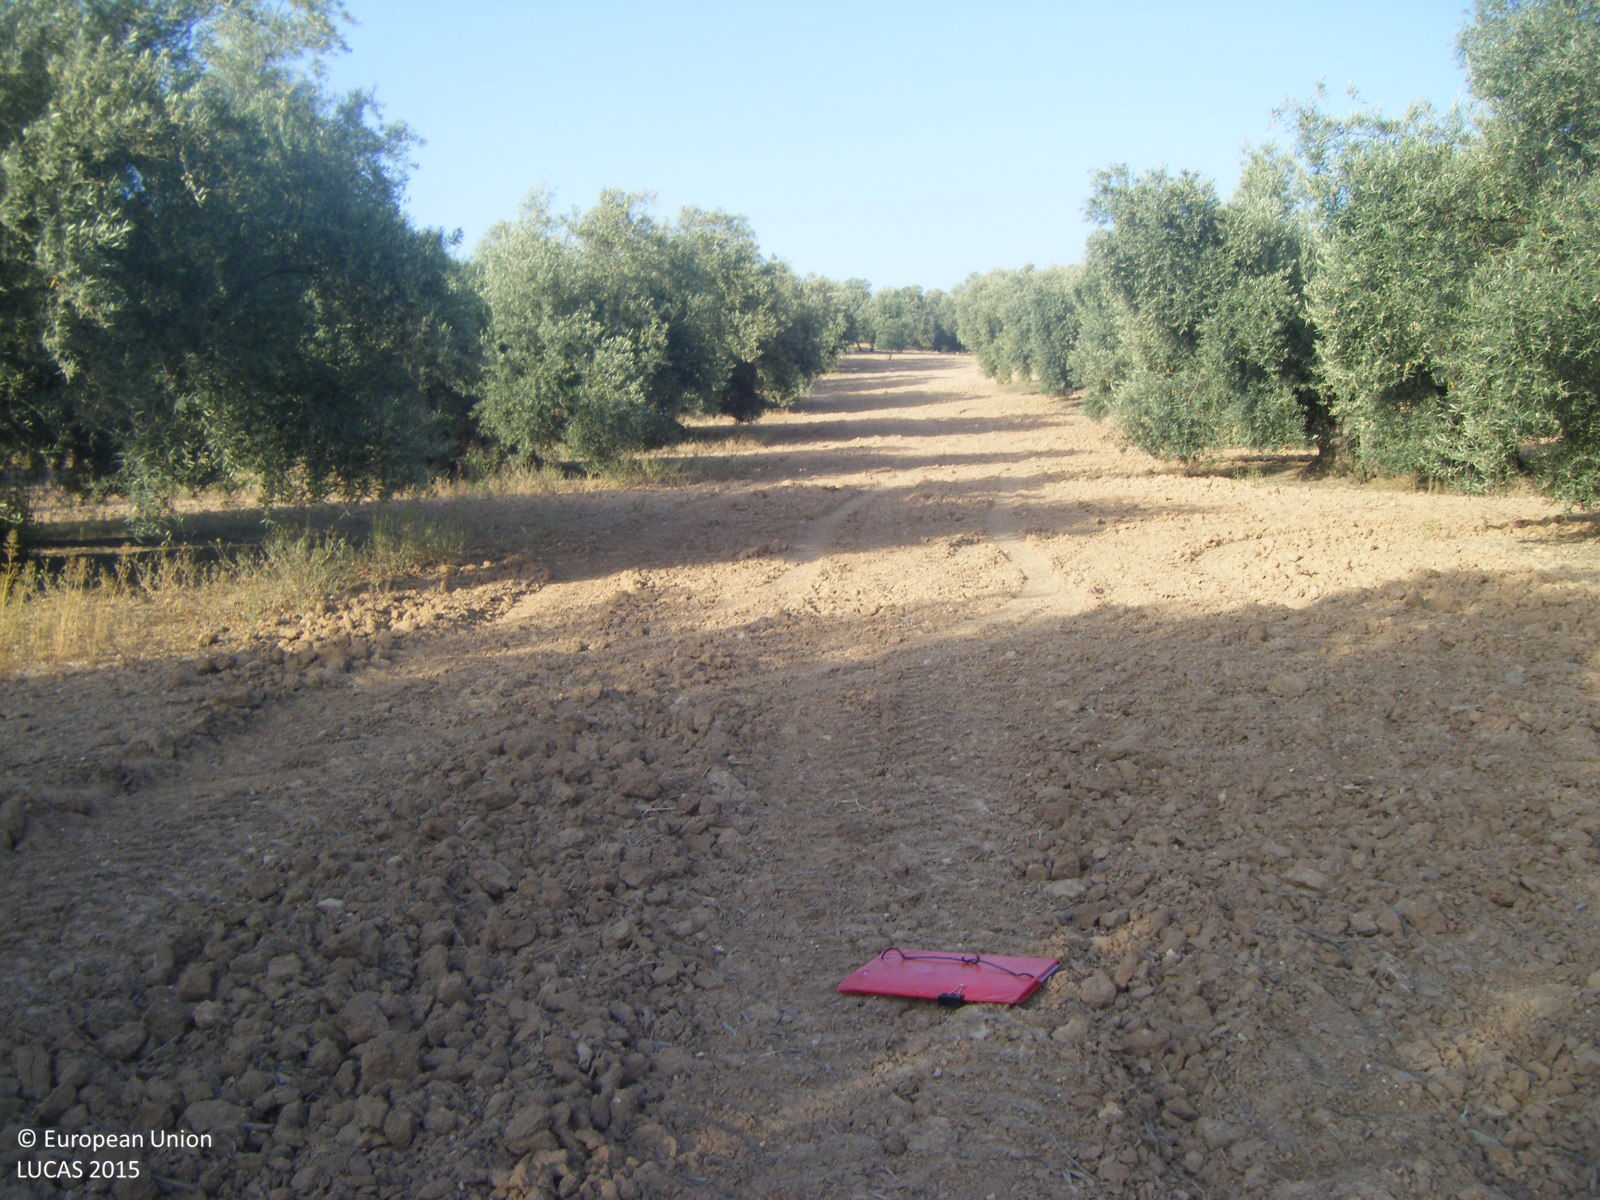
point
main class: Cropland
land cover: Olive groves
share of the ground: 25 - 50 %
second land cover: Other bare soil
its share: > 75 %
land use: Agriculture (excluding fallow land and kitchen gardens)
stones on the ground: < 10 %
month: May
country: ES
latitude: 37.3034
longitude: -4.5440
